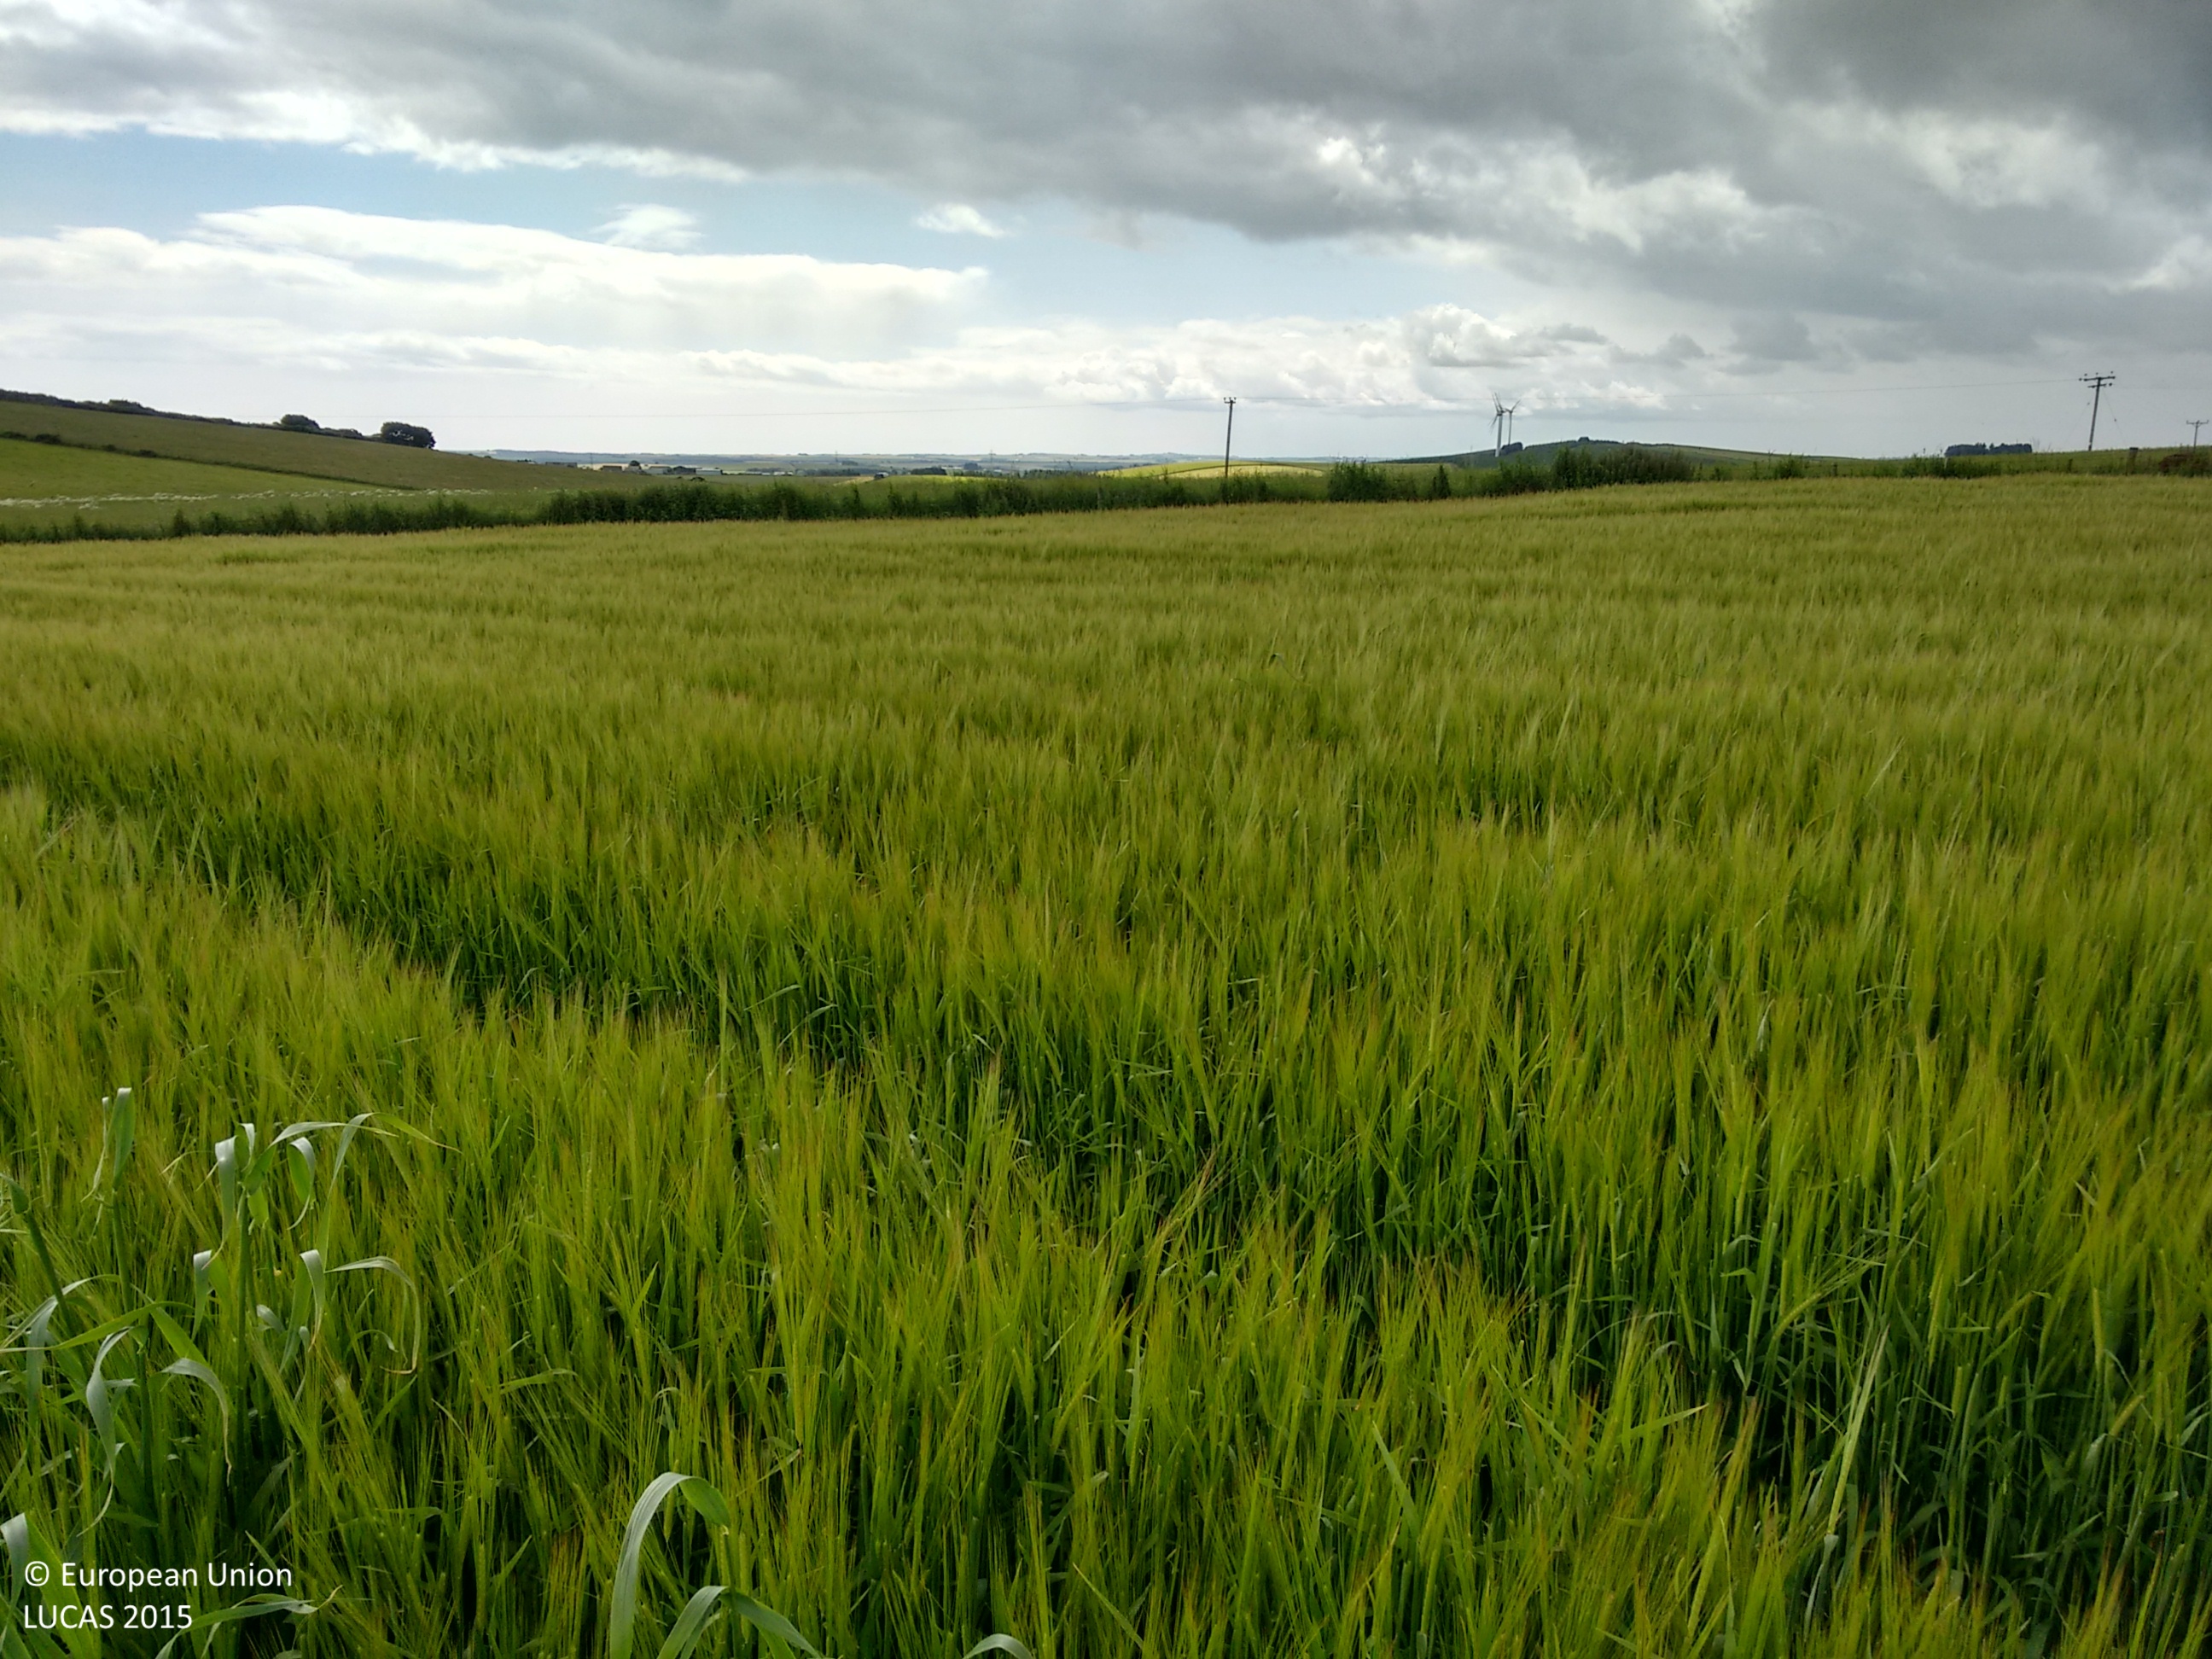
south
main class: Cropland
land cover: Barley
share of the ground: > 75 %
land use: Agriculture (excluding fallow land and kitchen gardens)
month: July
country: GB
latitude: 57.4198
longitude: -2.0513
